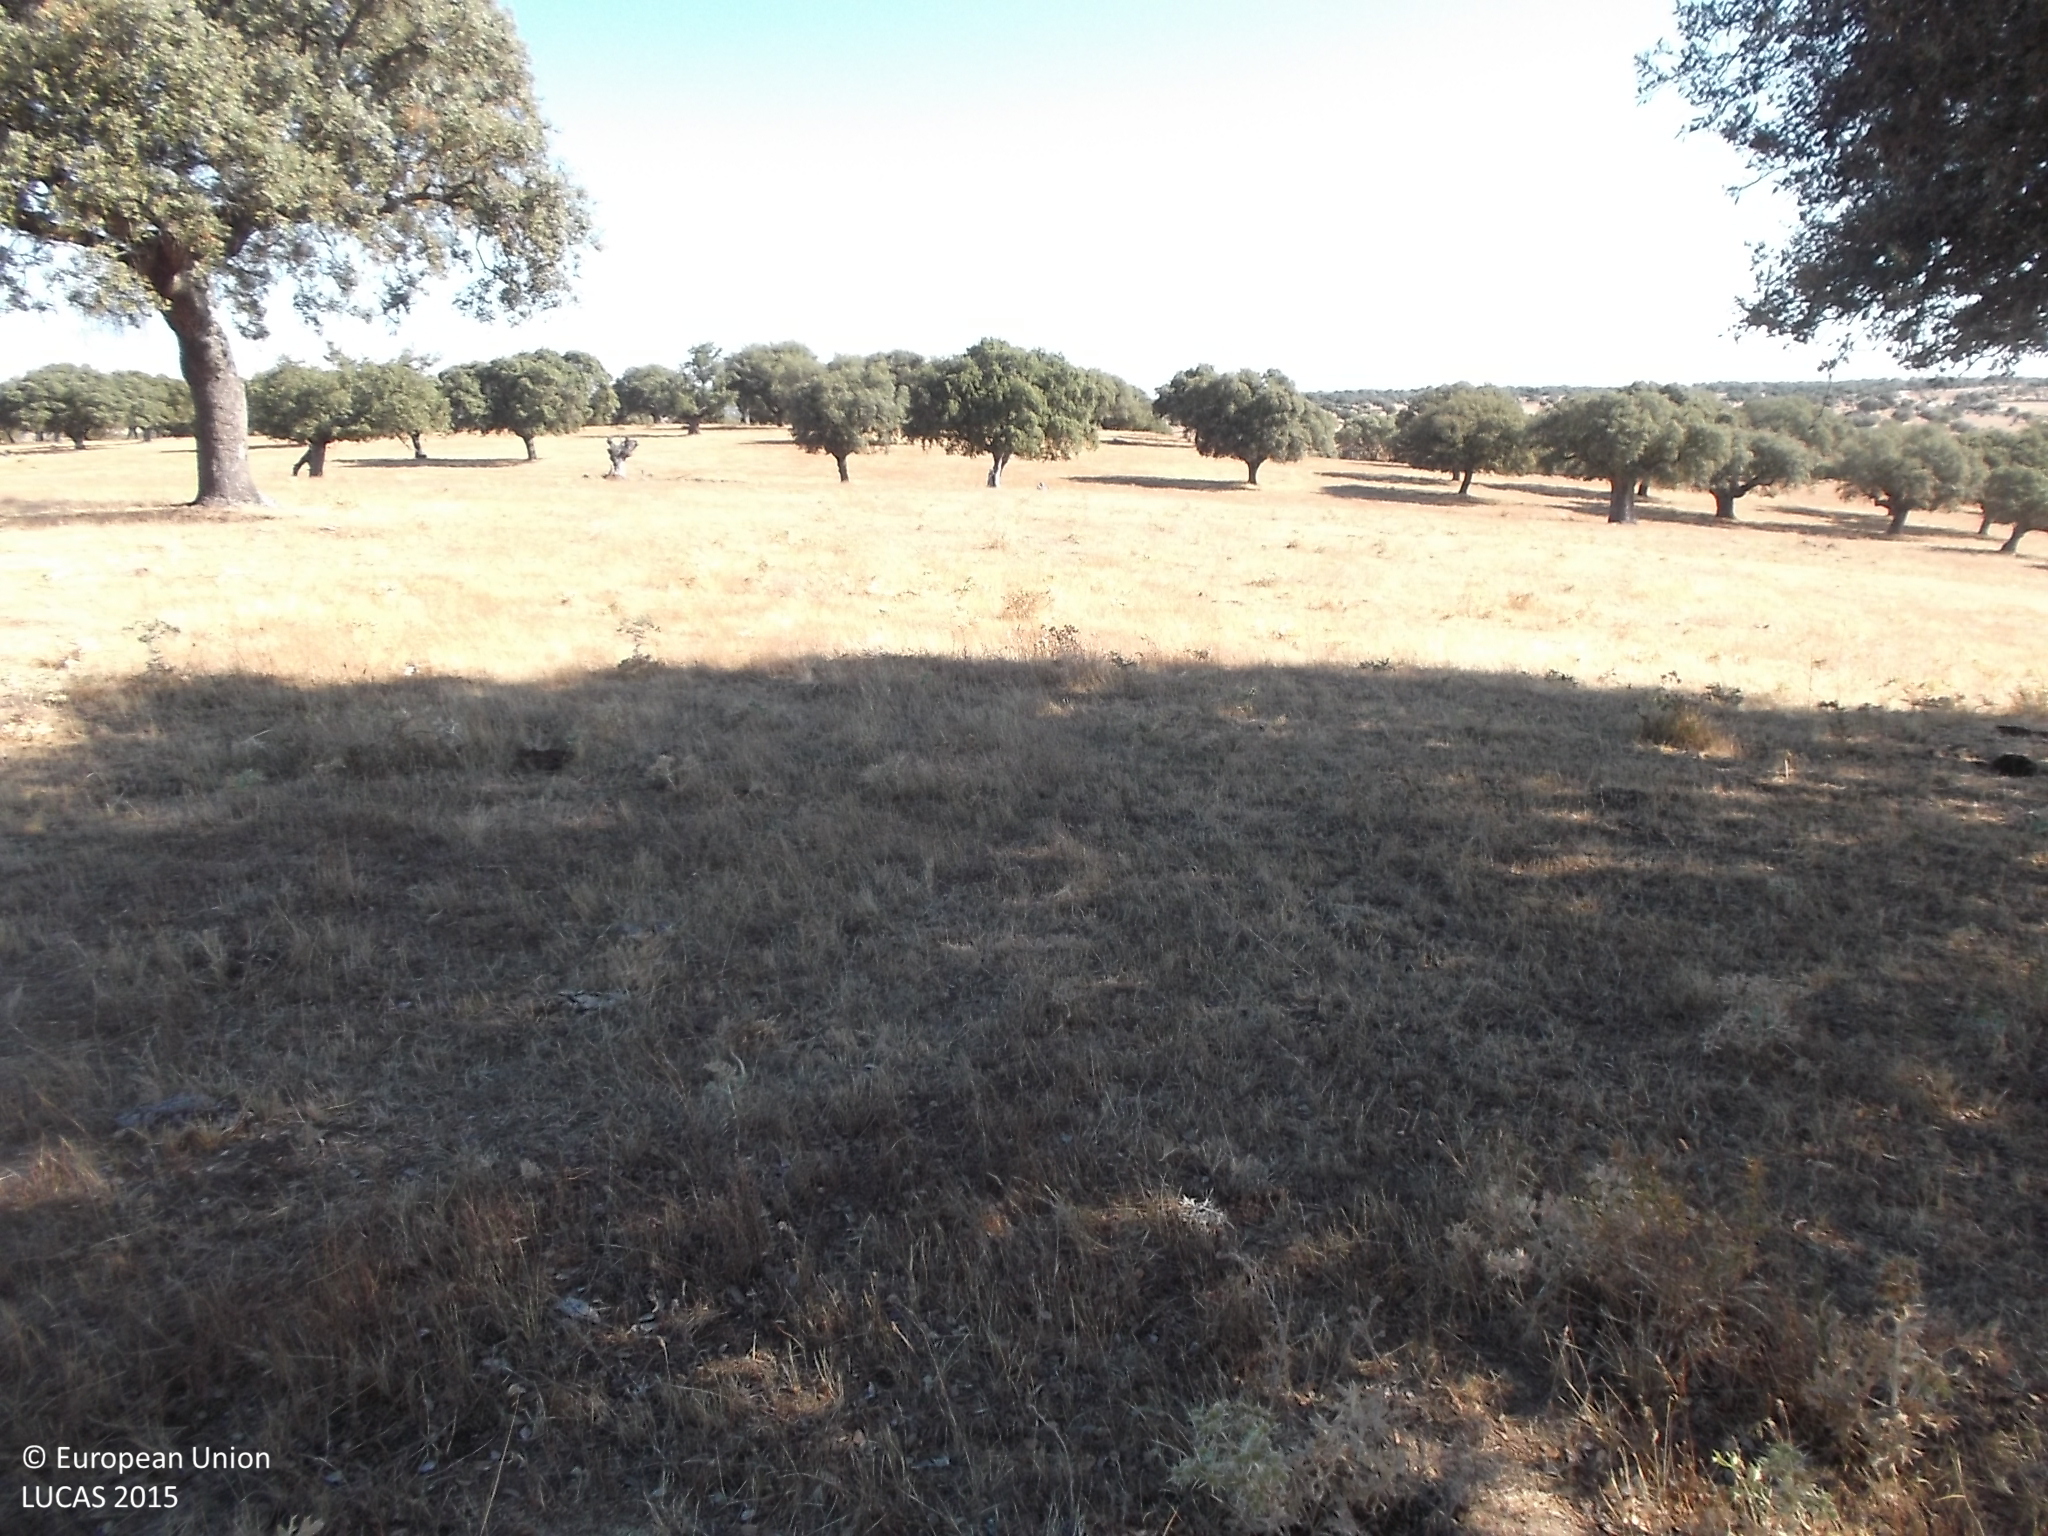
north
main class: Woodland
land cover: Broadleaved woodland
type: broadleaved evergreen forest
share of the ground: 10 - 25 %
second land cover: Grassland without tree/shrub cover
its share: > 75 %
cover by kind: herbaceous plants 85 %, broadleaved forest trees 15 %
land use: Forestry
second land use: Agriculture (excluding fallow land and kitchen gardens)
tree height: < 5 m
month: July
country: ES
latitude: 40.8837
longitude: -6.2882
